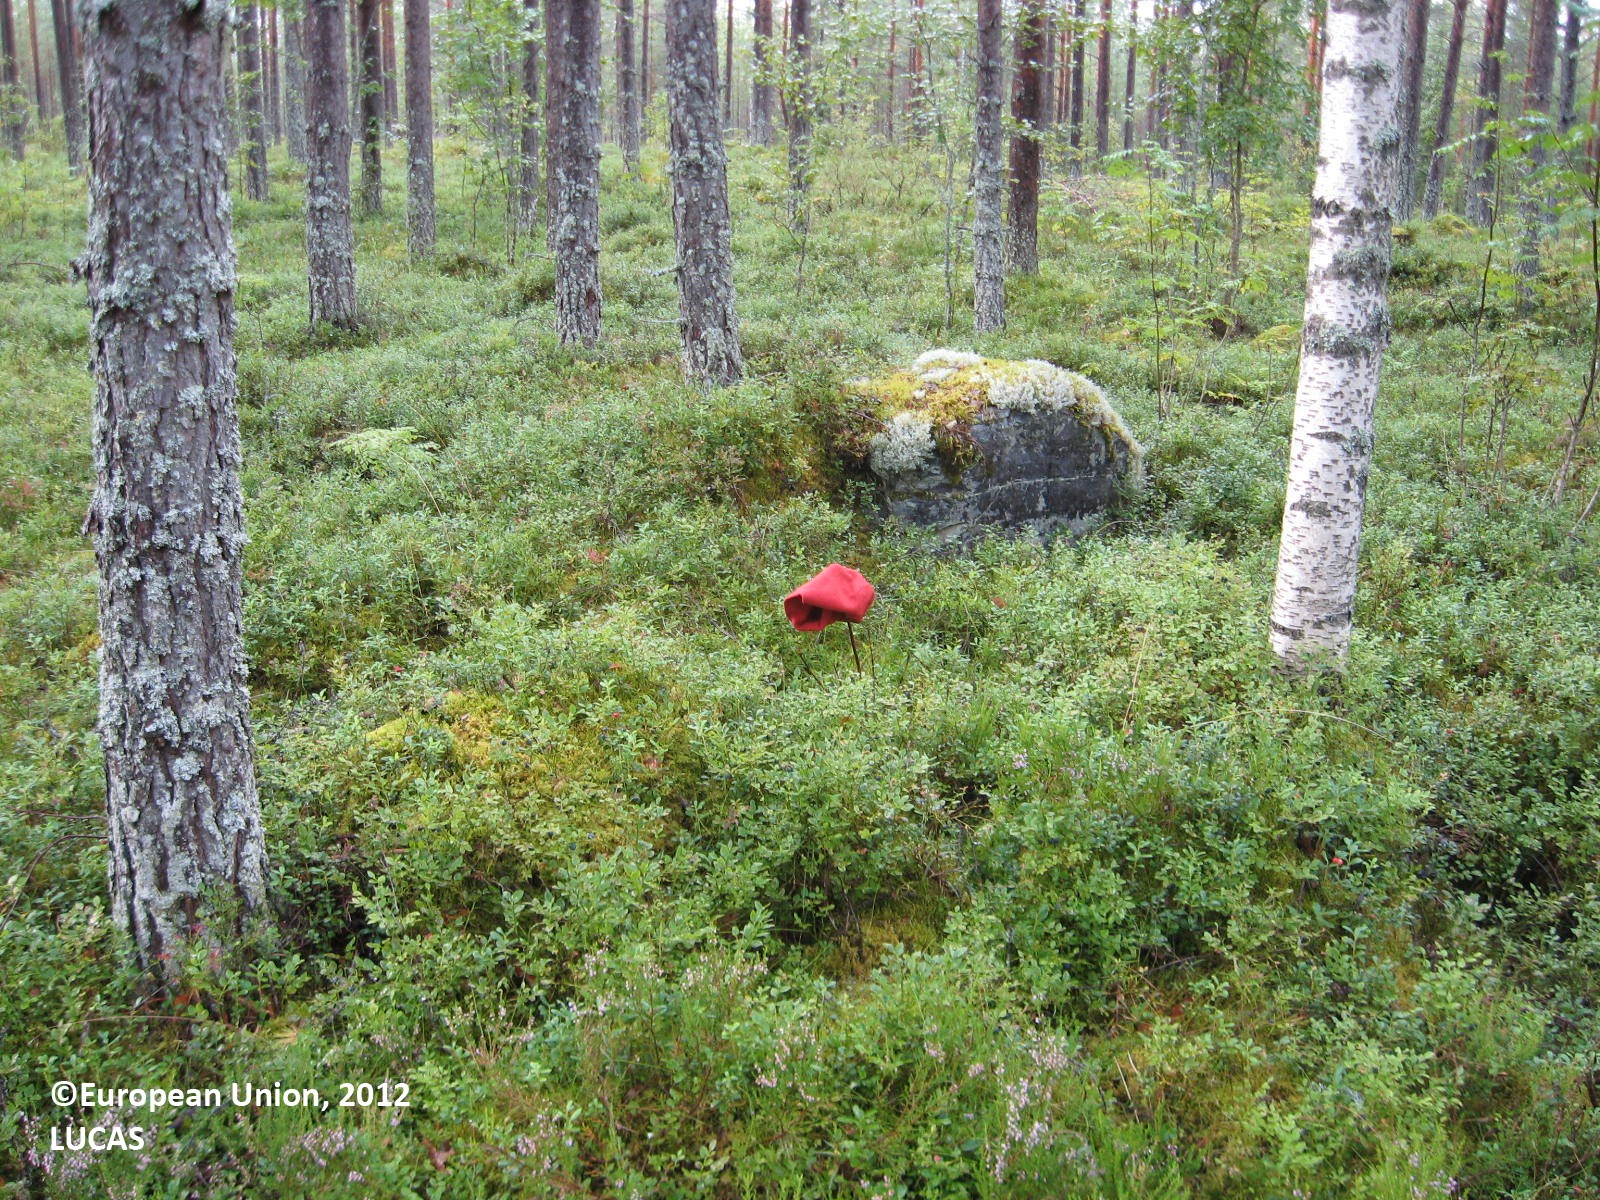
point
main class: Woodland
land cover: Pine dominated coniferous woodland
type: boreal forest
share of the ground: > 75 %
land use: Forestry
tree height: > 5 m
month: August
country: FI
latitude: 63.4404
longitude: 30.4130
